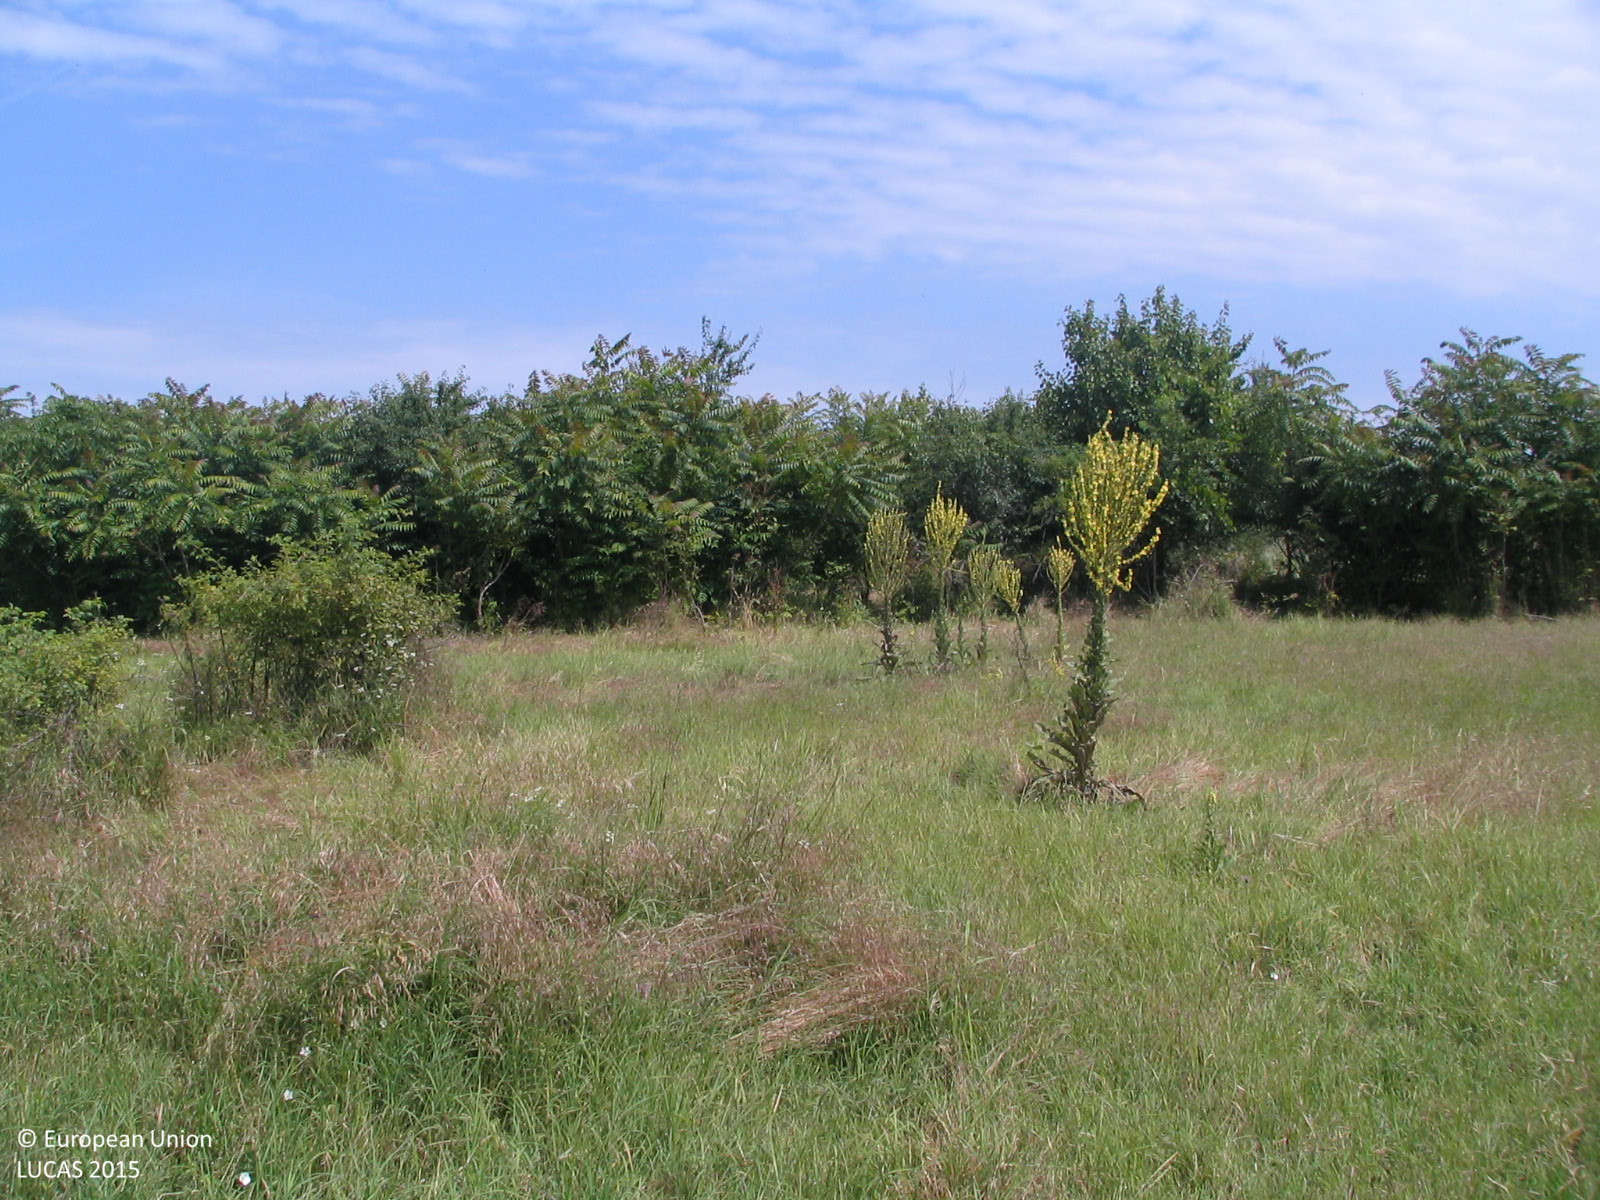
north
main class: Grassland
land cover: Grassland with sparse tree/shrub cover
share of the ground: > 75 %
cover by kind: herbaceous plants 90 %, broadleaved forest trees 5 %, shrubs 5 %
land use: Semi-natural and natural areas not in use
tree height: < 5 m
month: June
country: BG
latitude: 43.4757
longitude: 24.0855
